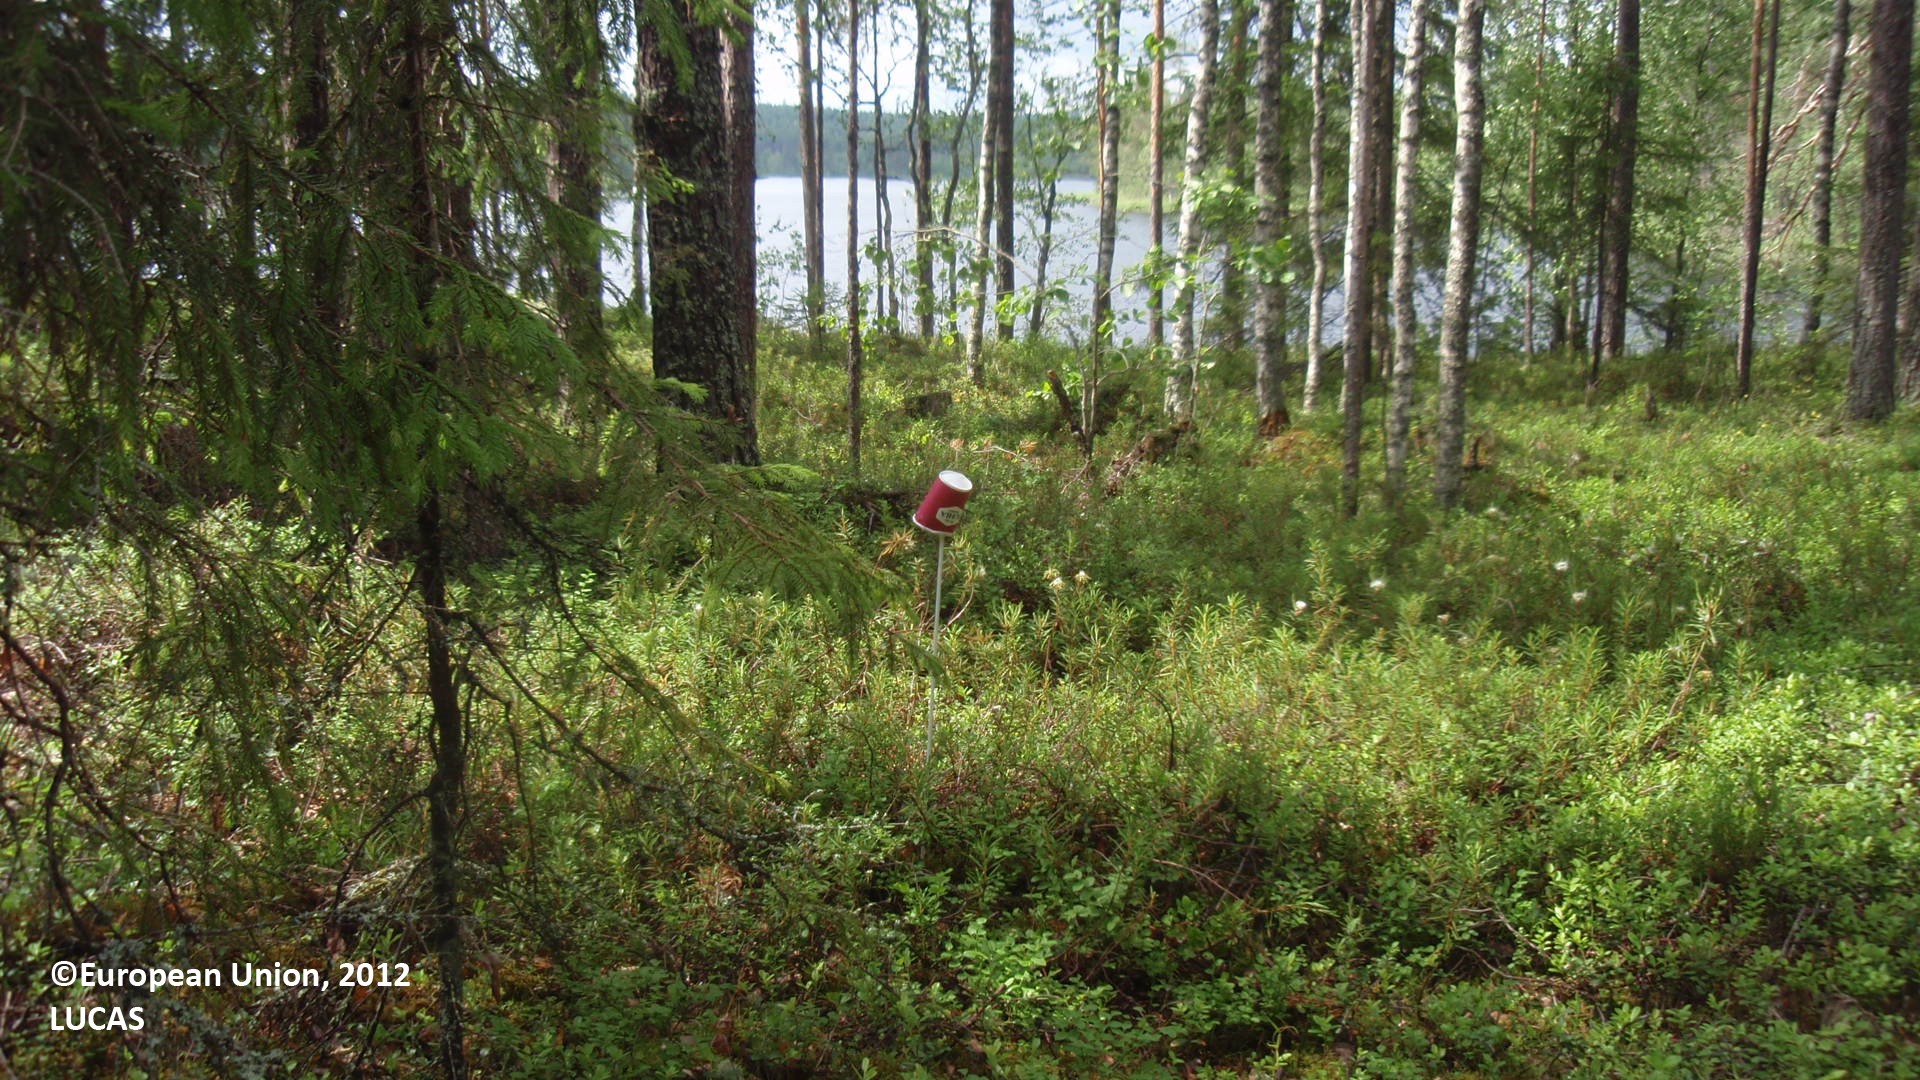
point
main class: Woodland
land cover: Pine dominated mixed woodland
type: boreal forest
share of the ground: 50 - 75 %
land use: Forestry
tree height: > 5 m
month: July
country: FI
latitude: 61.6277
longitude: 28.8422
